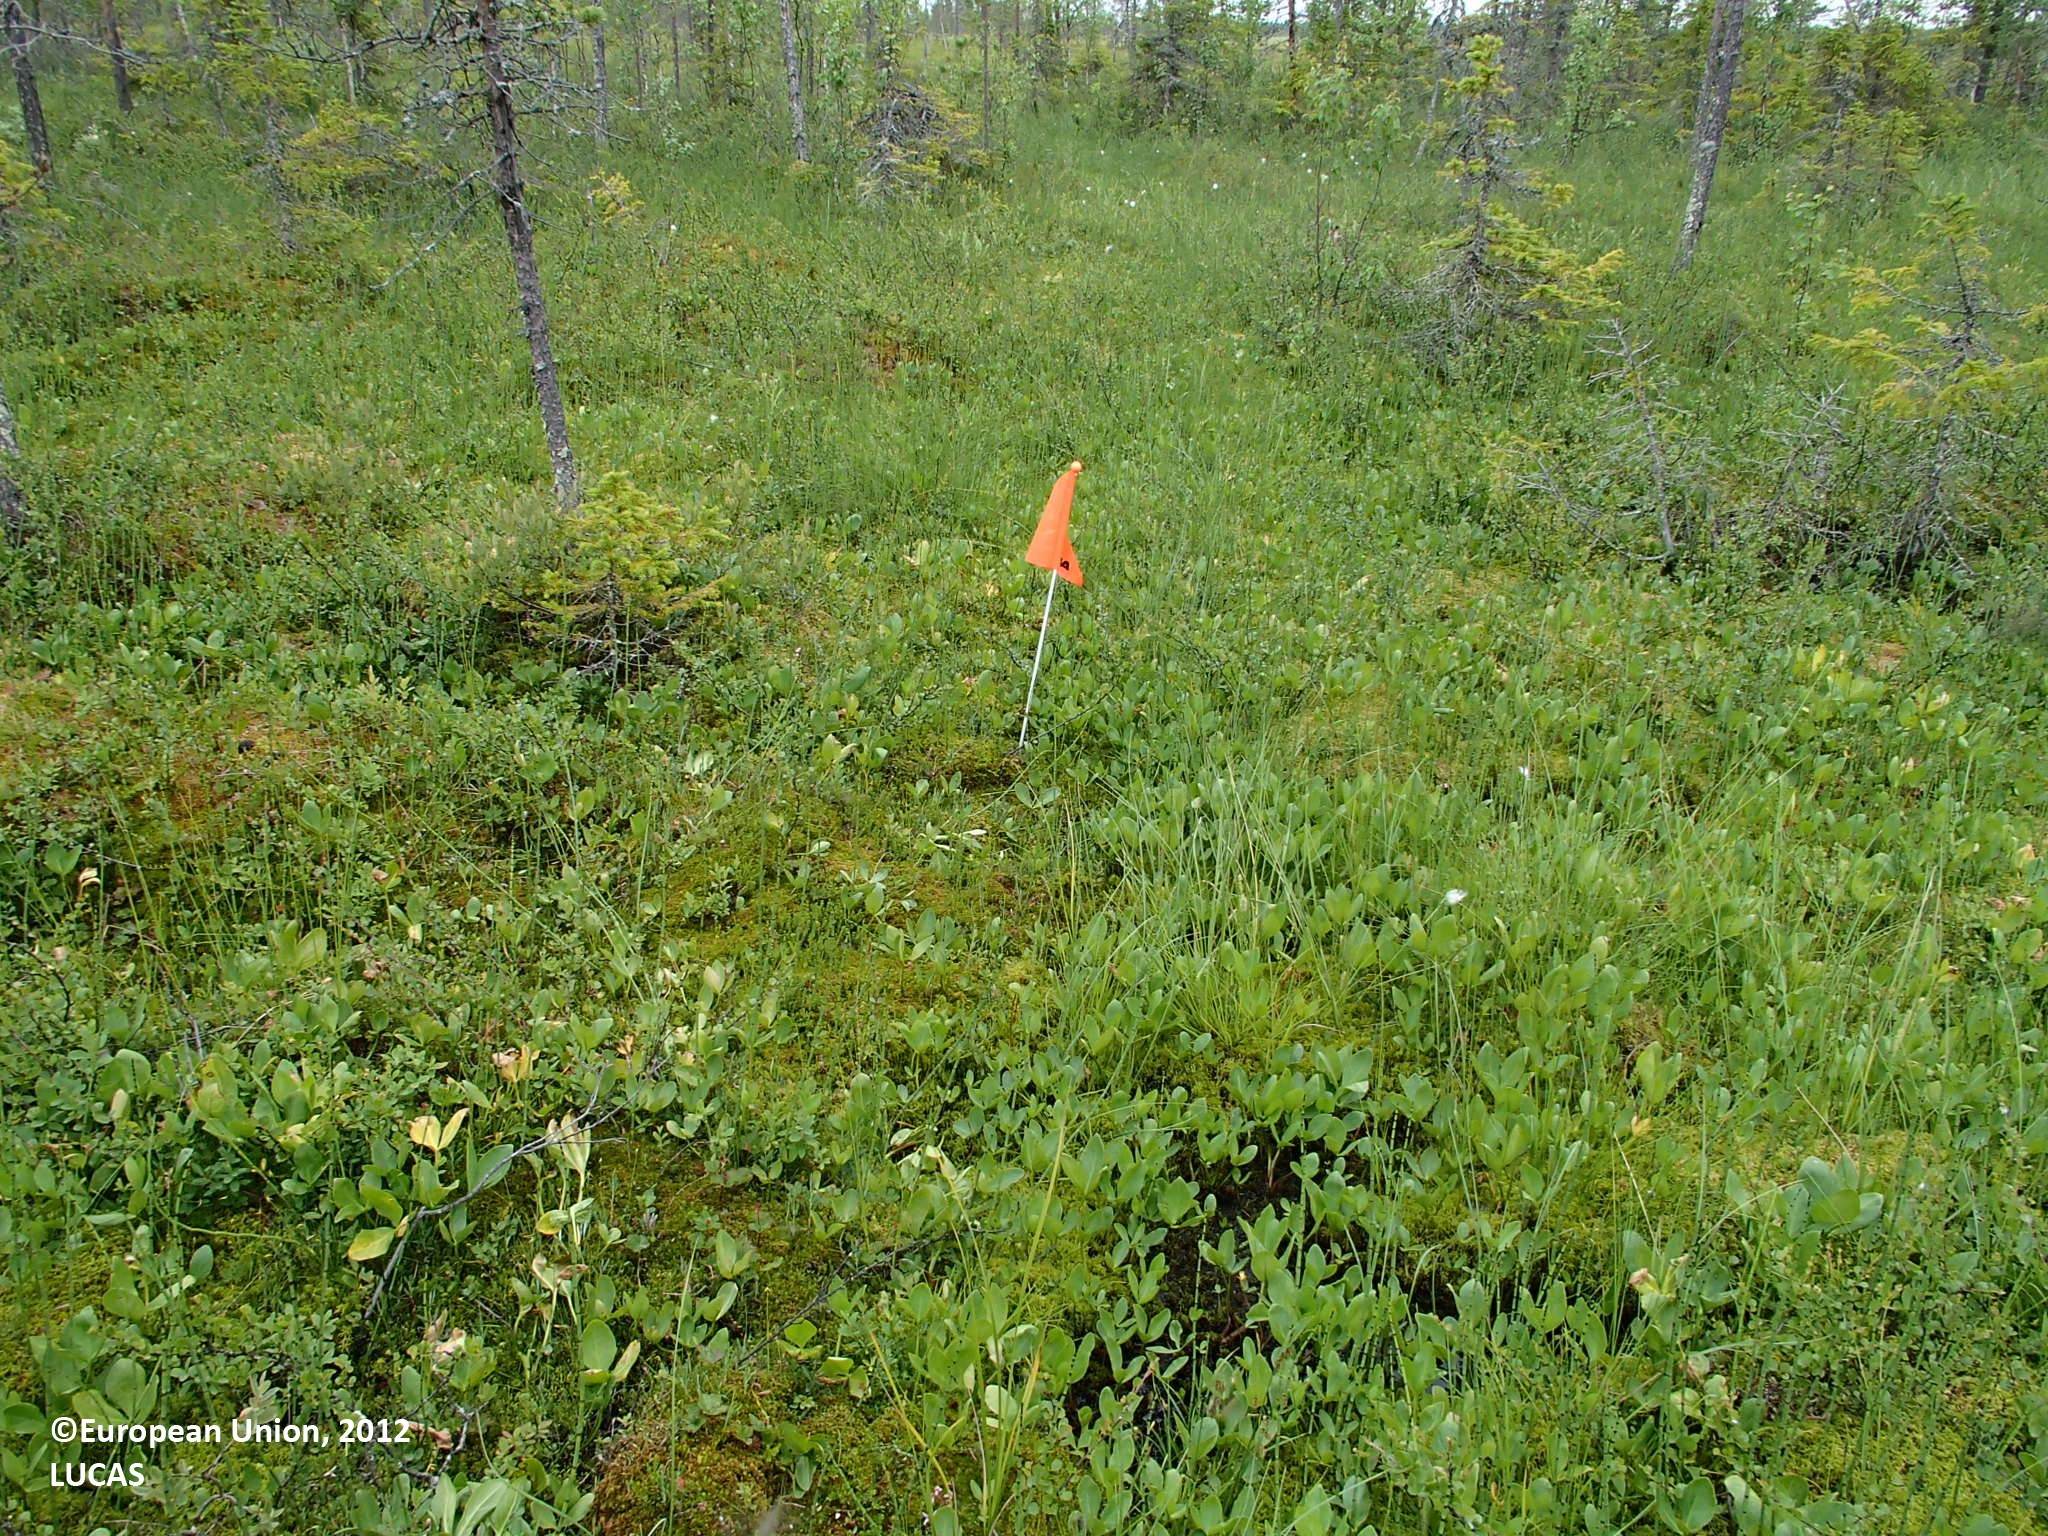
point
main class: Woodland
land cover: Pine dominated coniferous woodland
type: boreal forest
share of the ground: 10 - 25 %
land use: Forestry
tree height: > 5 m
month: July
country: FI
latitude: 67.3488
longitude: 25.9534
